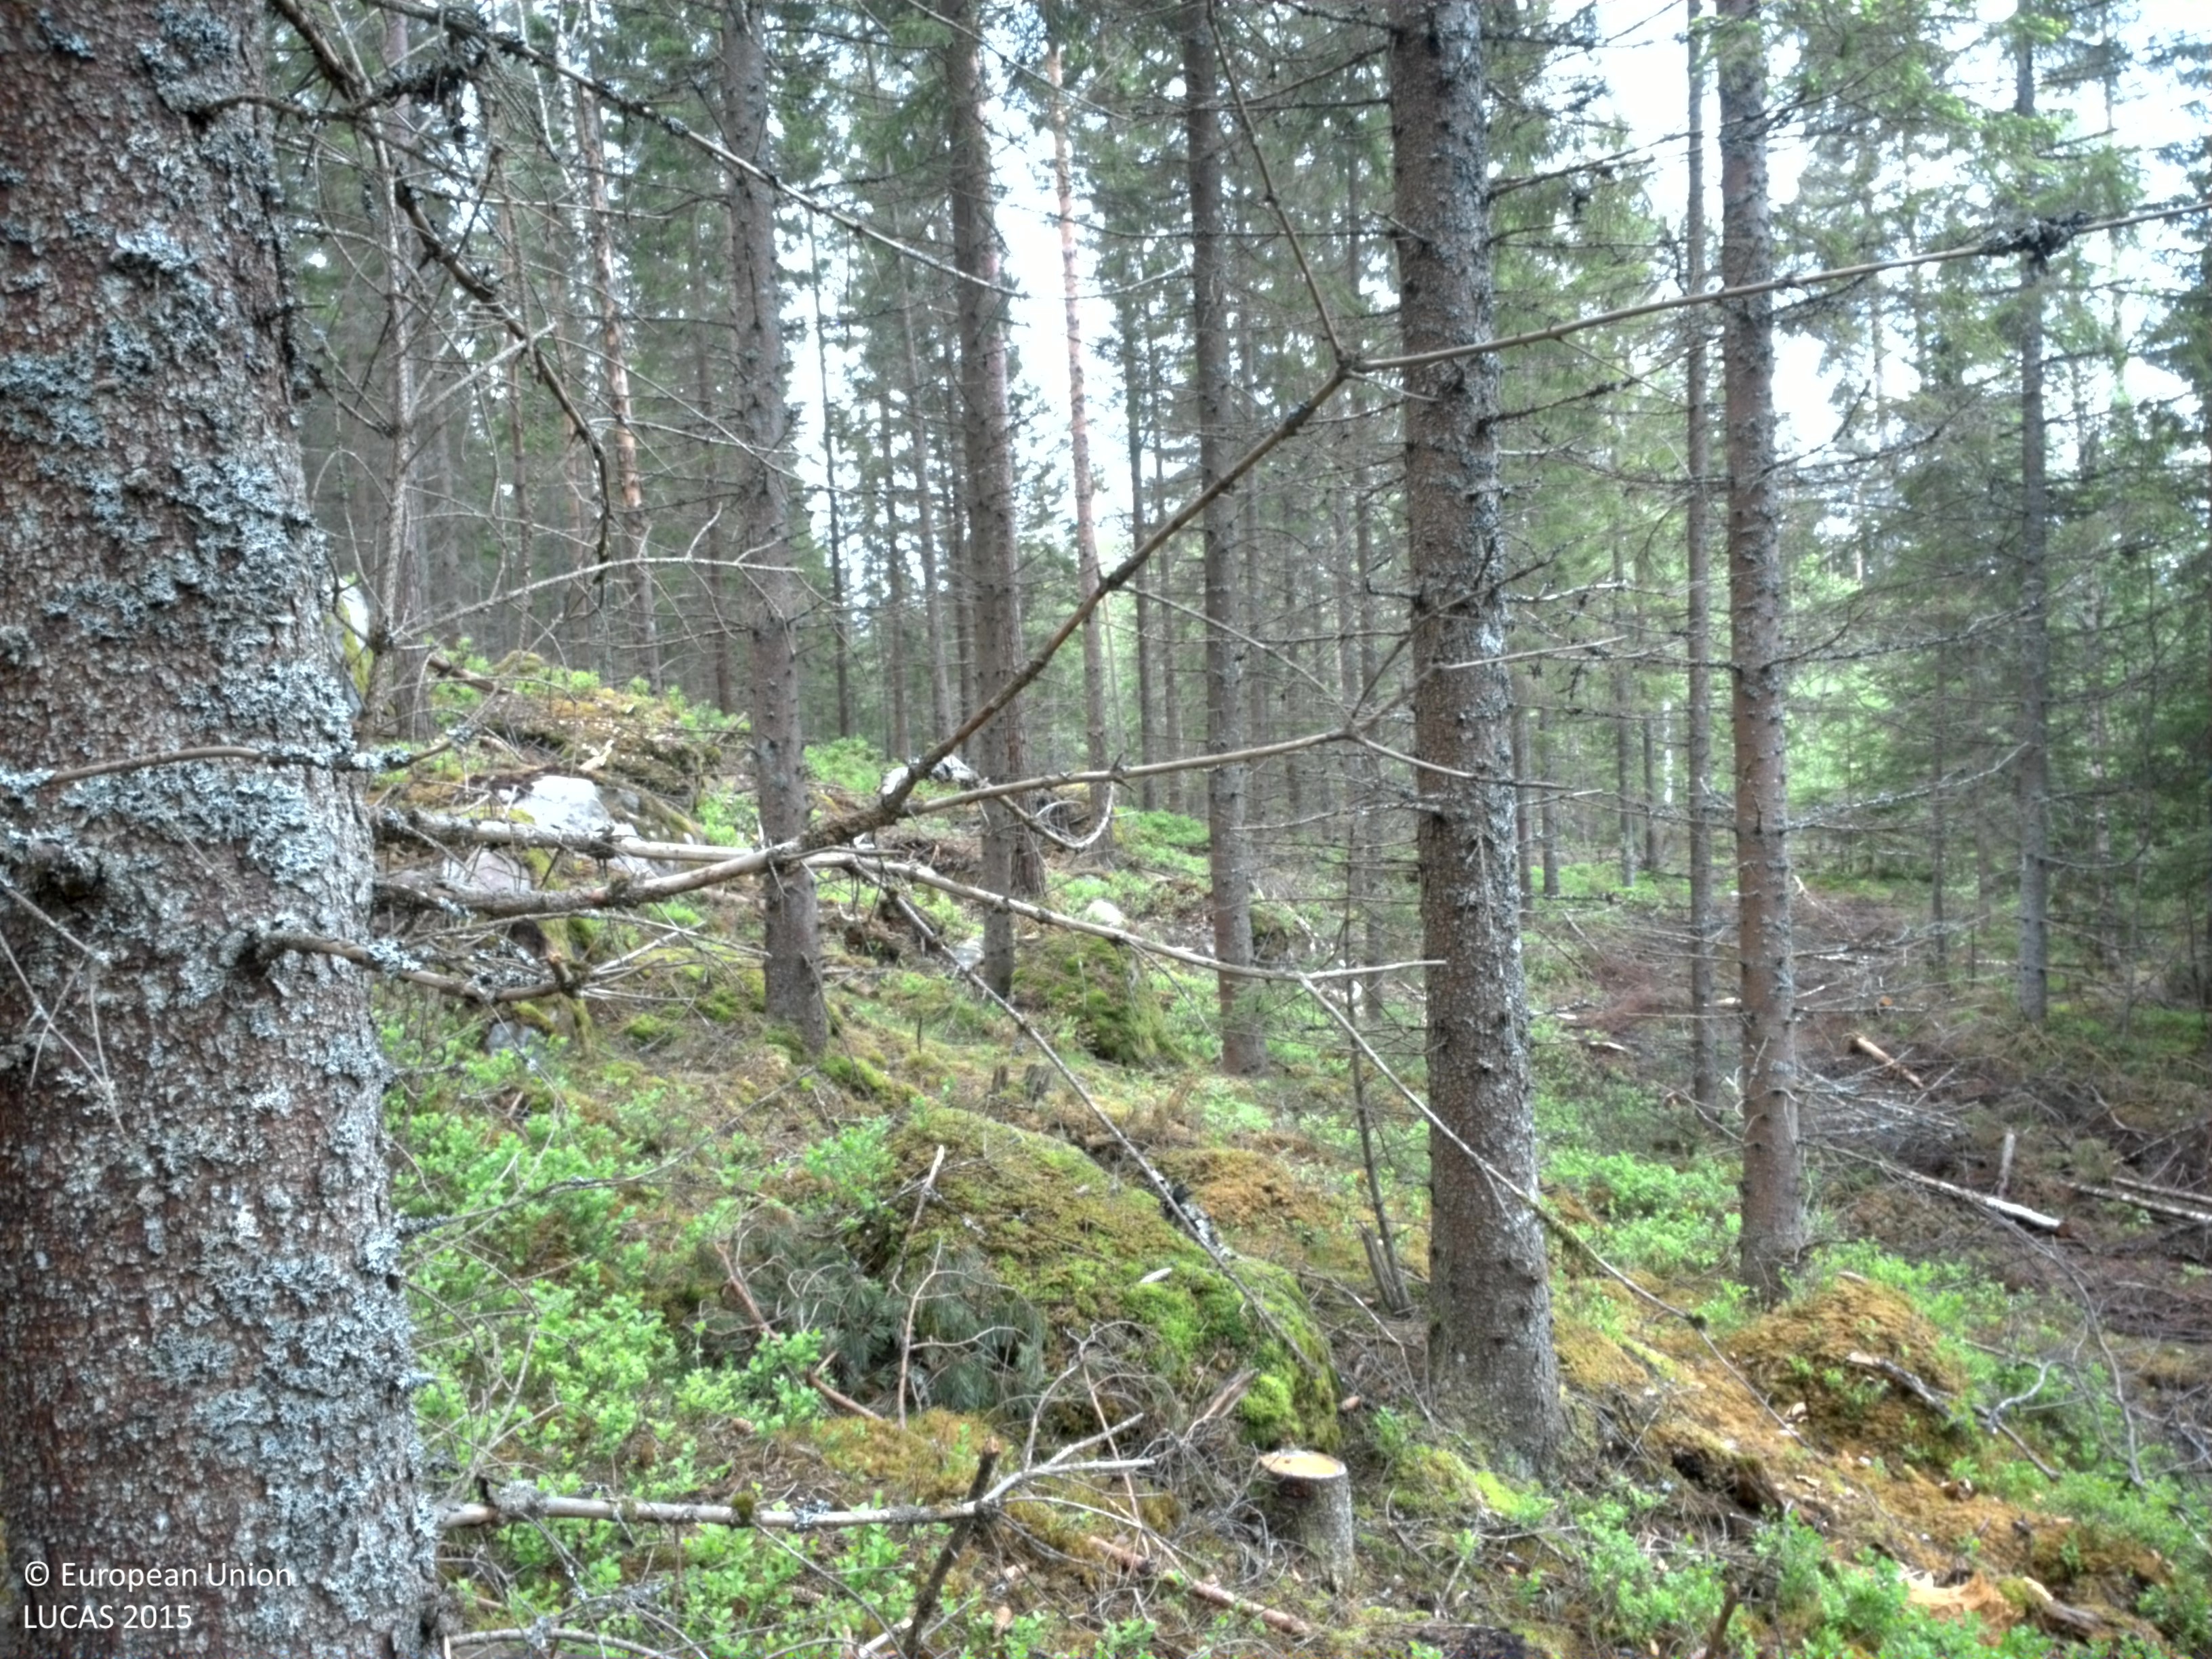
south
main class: Woodland
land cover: Spruce dominated coniferous woodland
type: boreal forest
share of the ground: 50 - 75 %
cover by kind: coniferous forest trees 50 %, shrubs 25 %, lichens and mosses 15 %, broadleaved forest trees 5 %, herbaceous plants 5 %
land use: Forestry
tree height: > 5 m
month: June
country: SE
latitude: 56.7640
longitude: 14.2994
